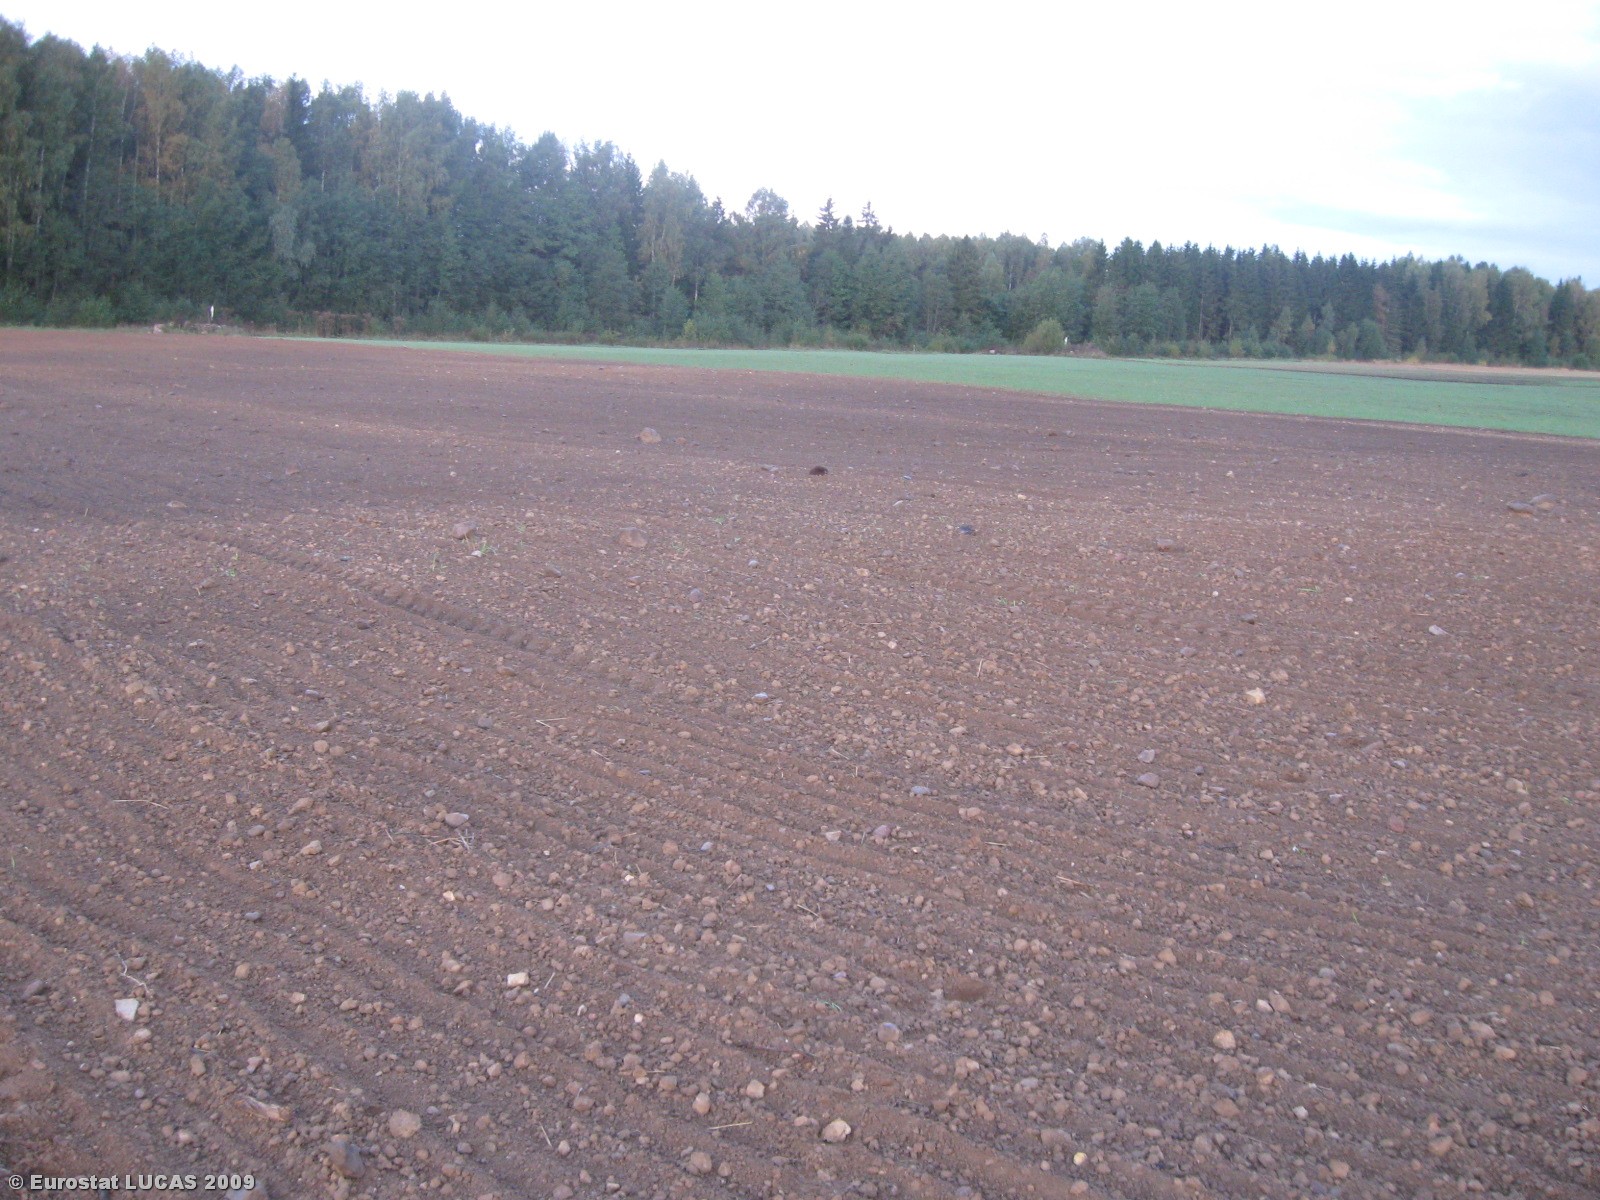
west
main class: Cropland
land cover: Rye
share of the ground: < 10 %
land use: Agriculture (excluding fallow land and kitchen gardens)
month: September
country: LT
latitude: 56.1685
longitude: 25.2375
